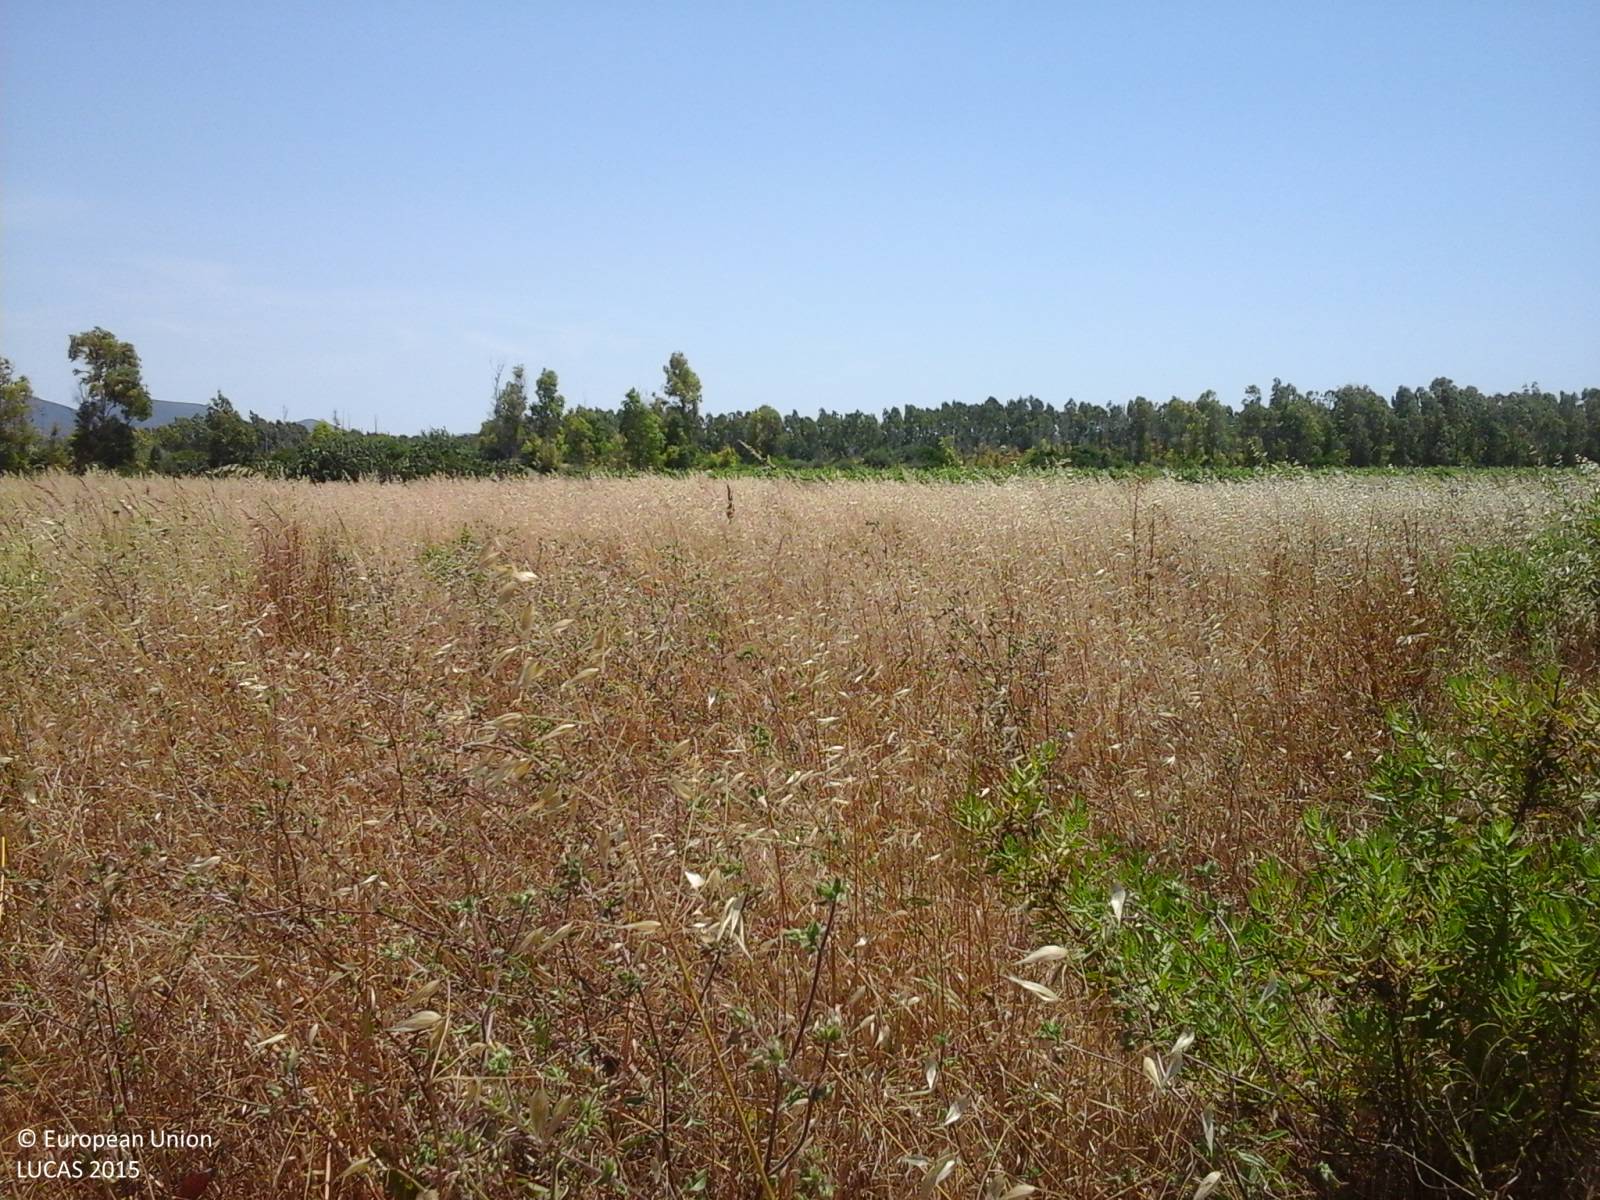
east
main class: Grassland
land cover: Spontaneously vegetated surfaces
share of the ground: > 75 %
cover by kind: herbaceous plants 90 %, unconsolidated bare surface 10 %
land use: Agriculture (excluding fallow land and kitchen gardens)
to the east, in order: Spontaneously vegetated surfaces; Electric lines; Spontaneously vegetated surfaces; Tracks; Broadleaved woodland; Ditches and canals; Tracks; Spontaneously vegetated surfaces
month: June
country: IT
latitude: 39.0434
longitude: 8.5879
